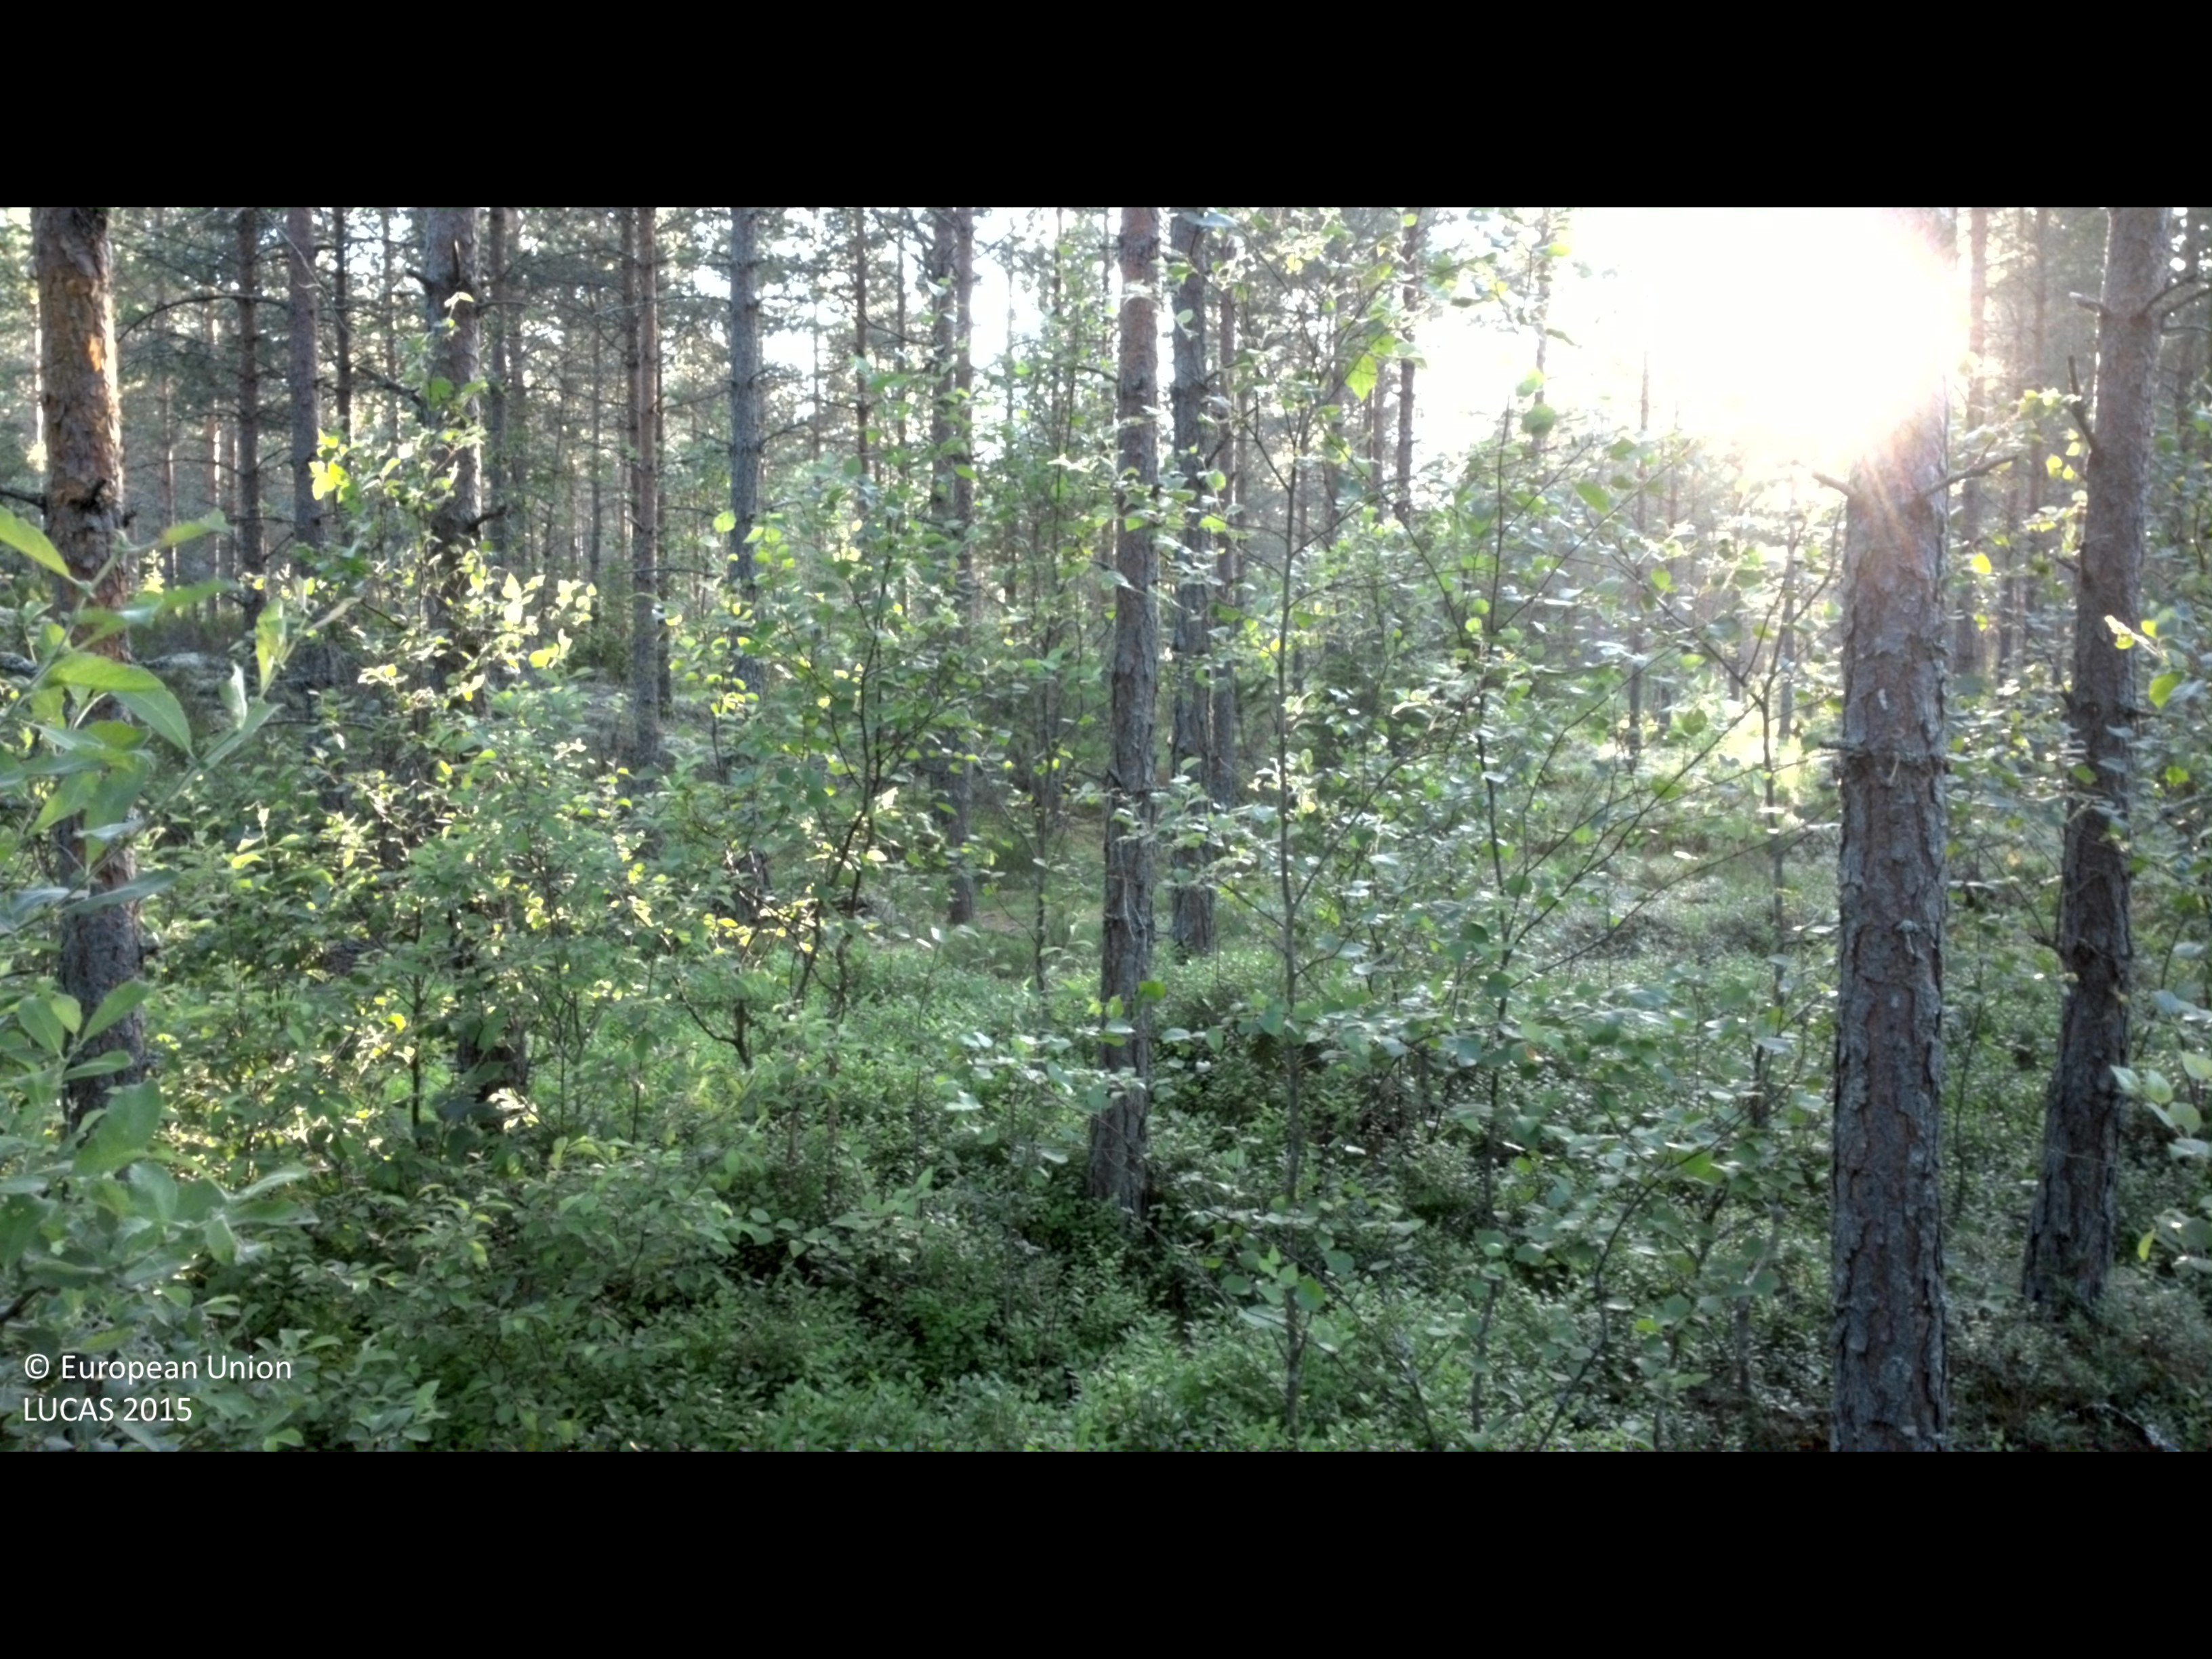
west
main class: Woodland
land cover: Pine dominated coniferous woodland
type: boreal forest
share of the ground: 50 - 75 %
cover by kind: coniferous forest trees 55 %, shrubs 25 %, broadleaved forest trees 15 %, lichens and mosses 5 %
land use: Forestry
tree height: > 5 m
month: July
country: SE
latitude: 58.3508
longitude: 16.5067
